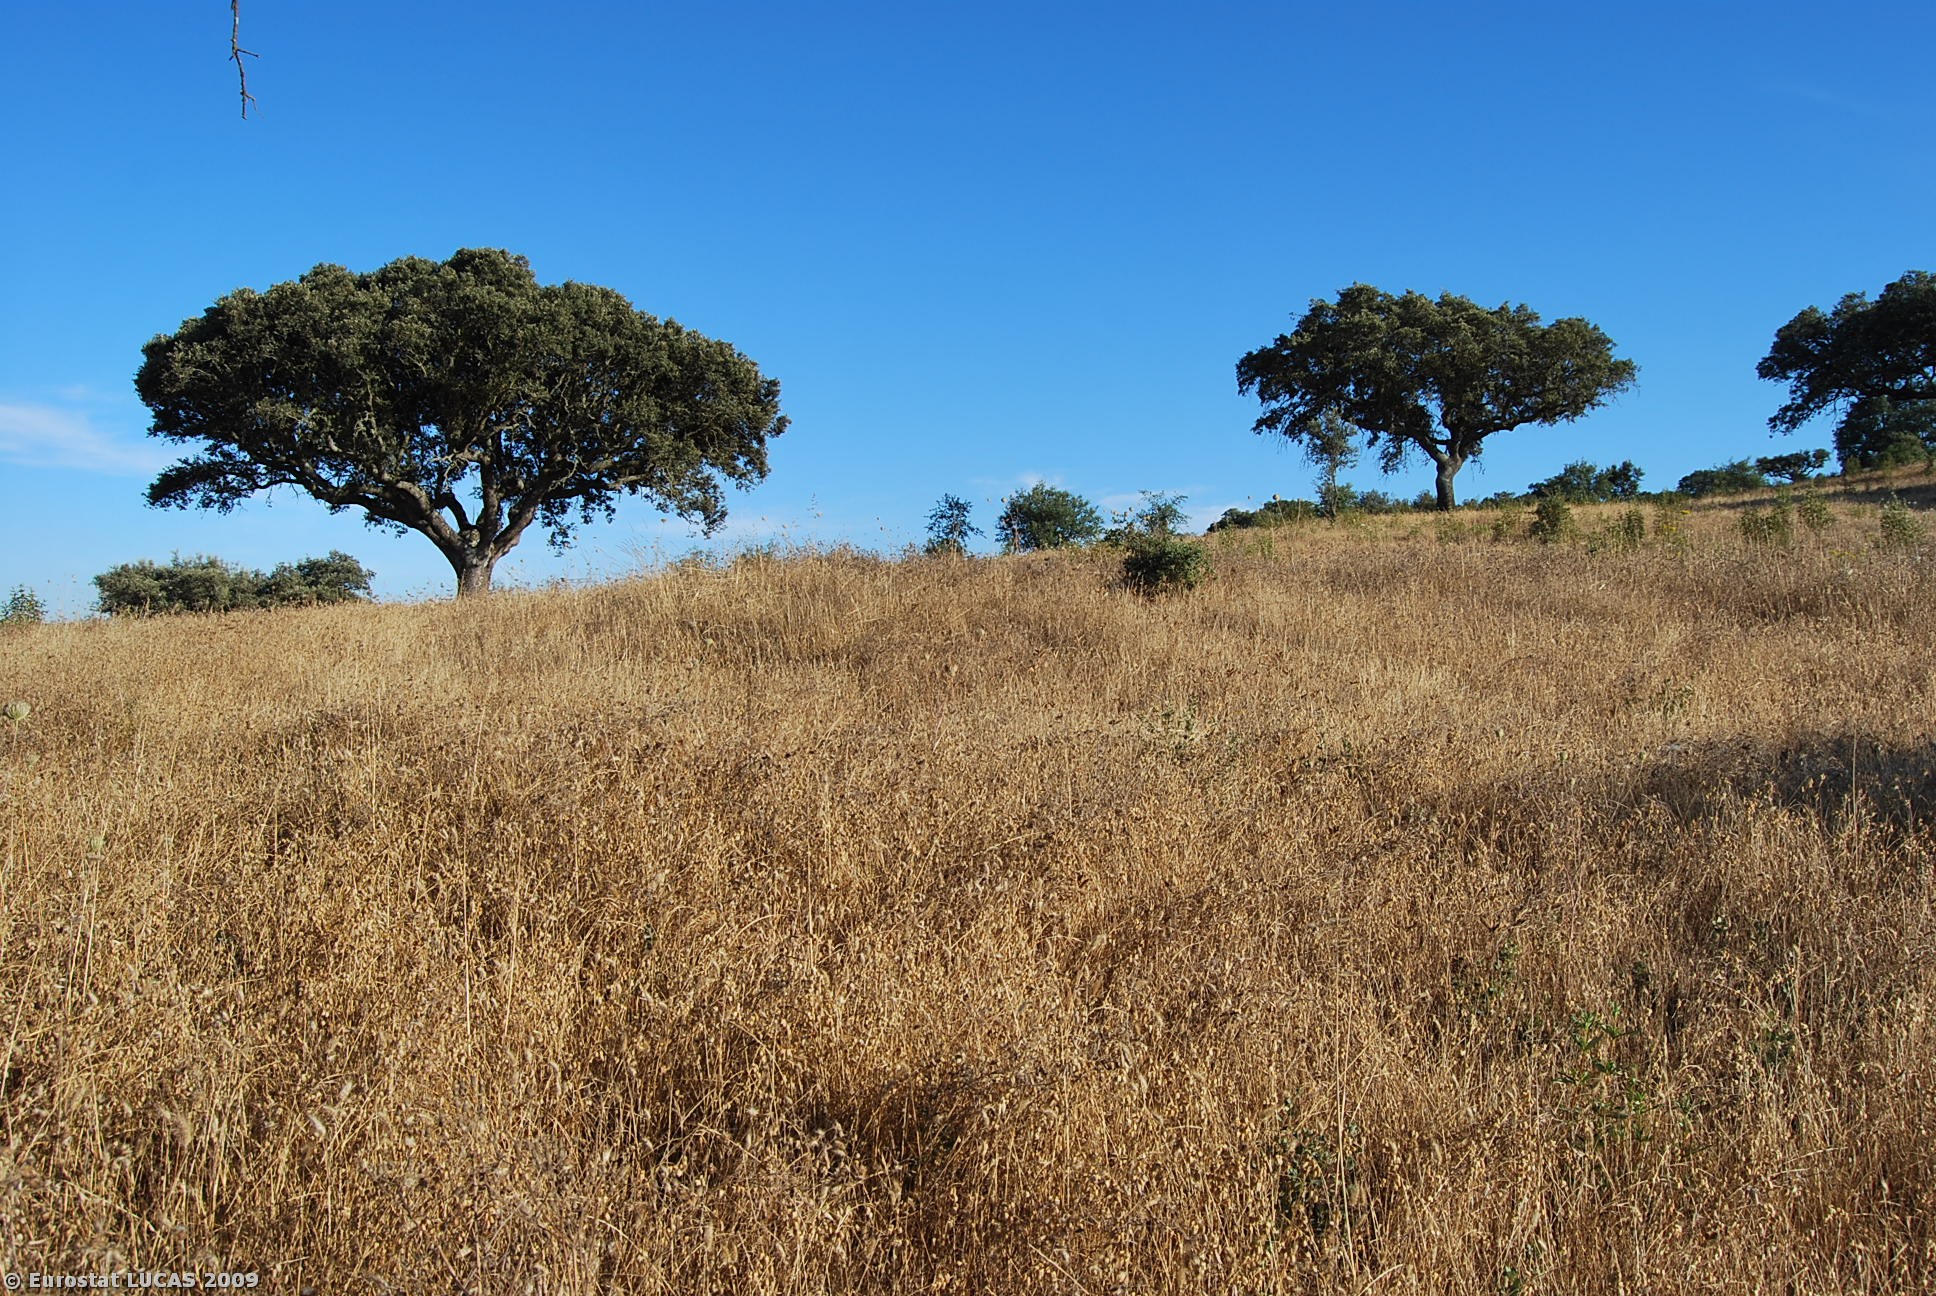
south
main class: Woodland
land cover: Broadleaved woodland
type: broadleaved evergreen forest
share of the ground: 10 - 25 %
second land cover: Spontaneously vegetated surfaces
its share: 50 - 75 %
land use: Forestry
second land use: Fallow land
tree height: > 5 m
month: July
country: PT
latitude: 37.6387
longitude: -8.2172
